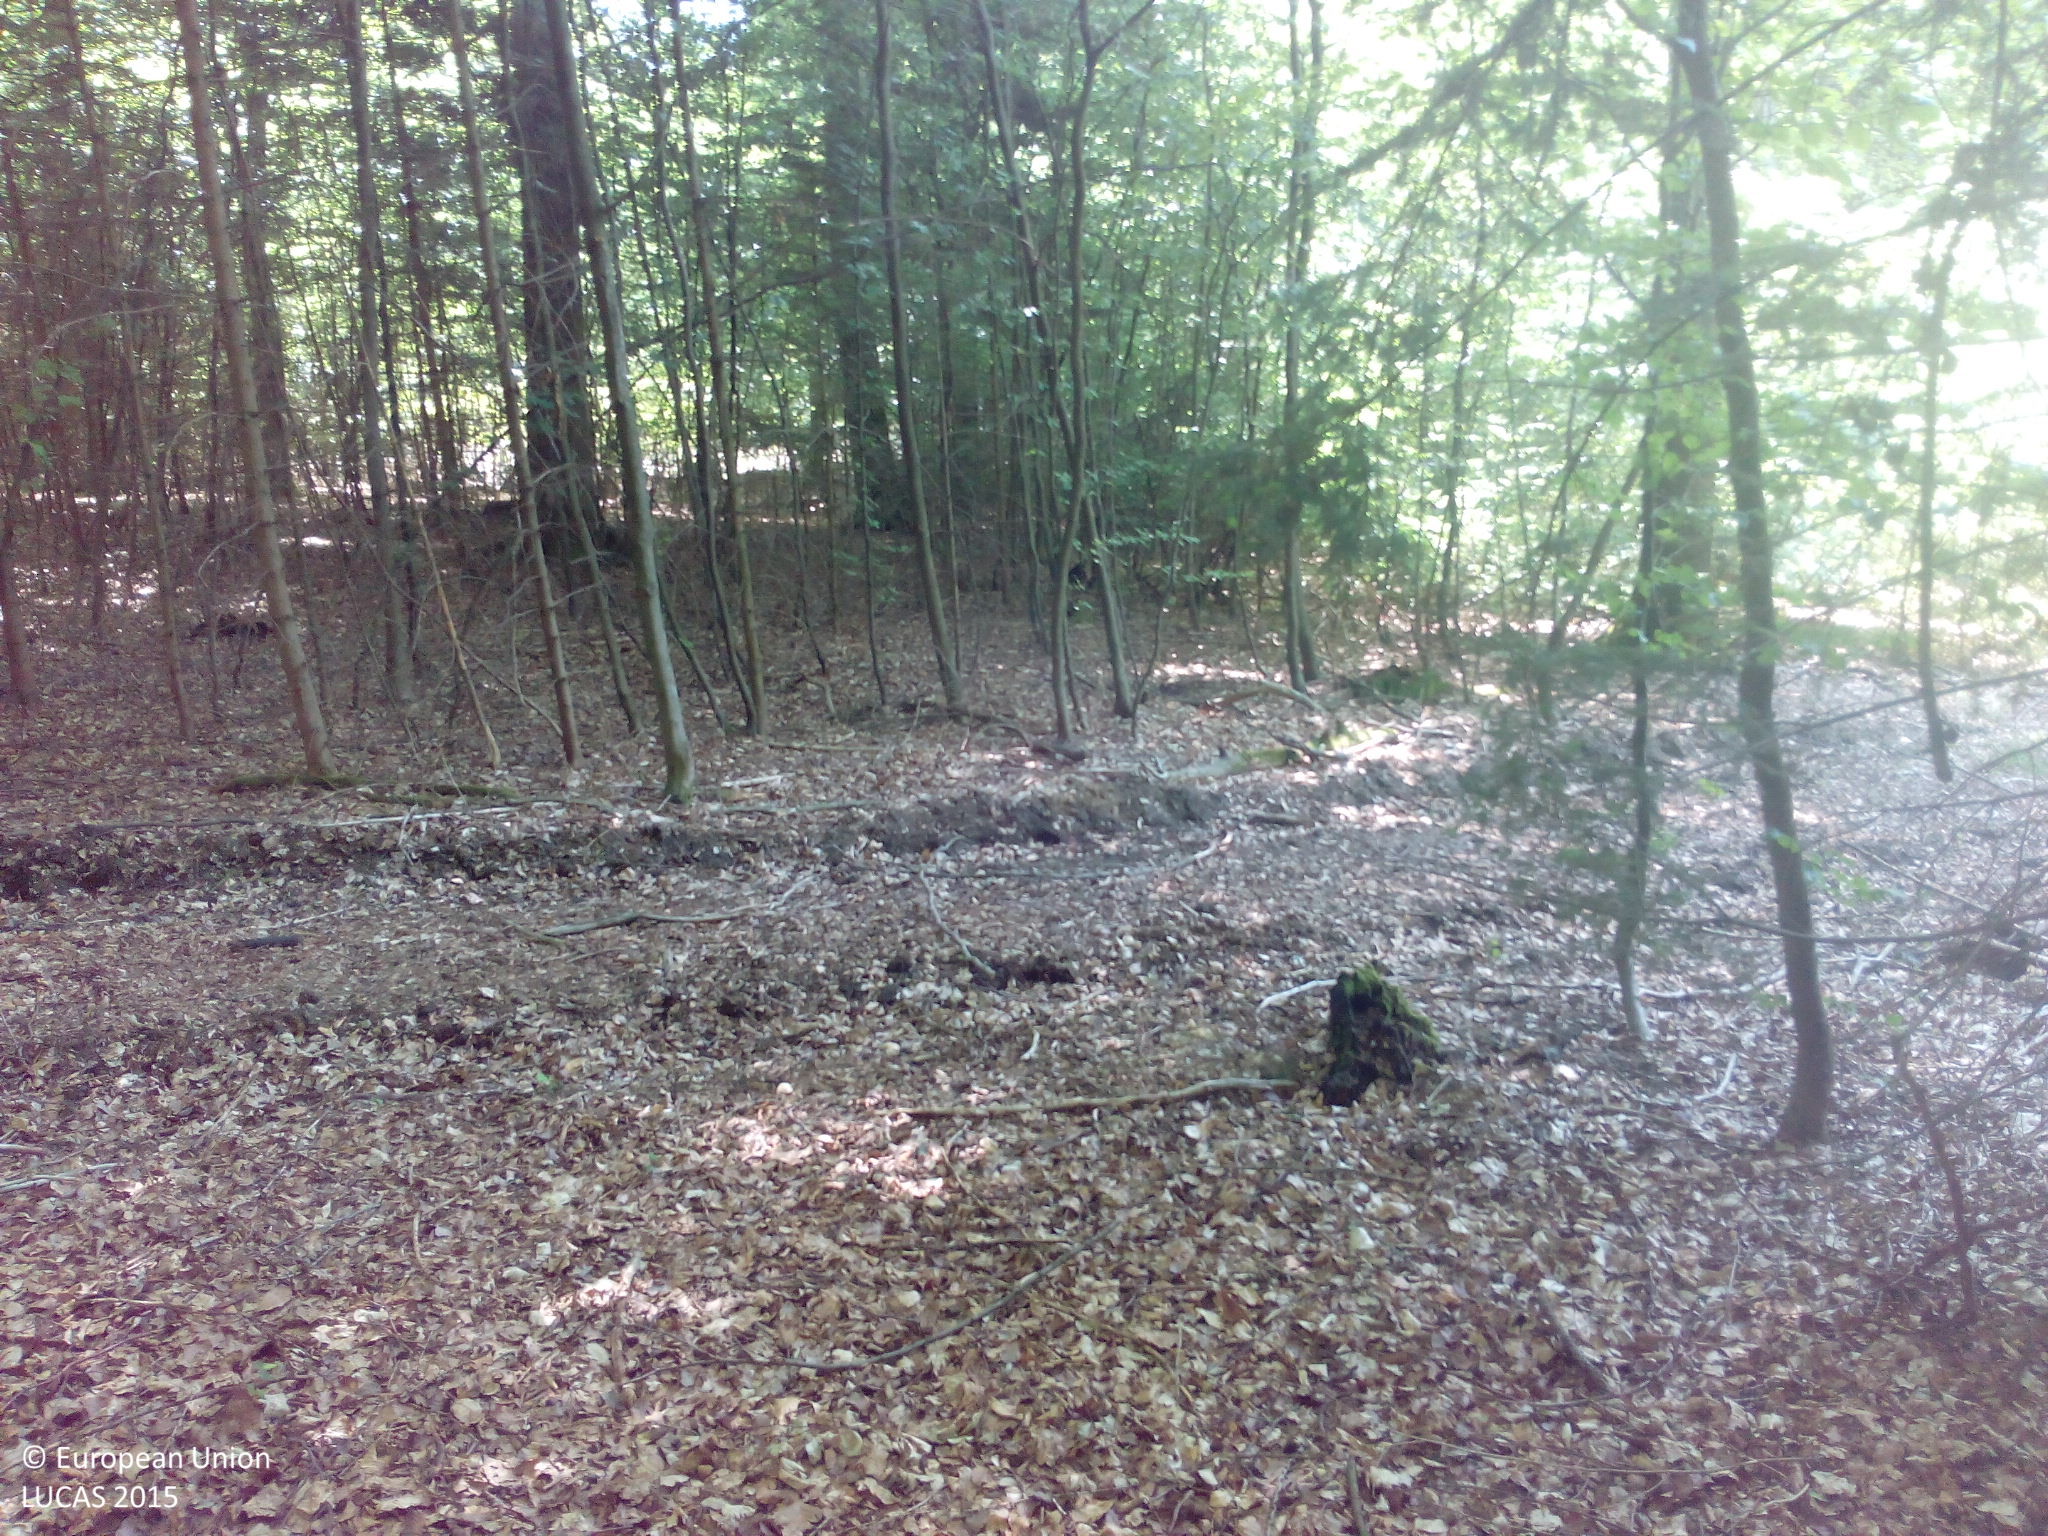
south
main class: Woodland
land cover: Broadleaved woodland
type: mesophytic deciduous forest
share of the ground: > 75 %
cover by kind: broadleaved forest trees 95 %, unconsolidated bare surface 5 %
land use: Forestry
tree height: > 5 m
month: June
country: DE
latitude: 50.1147
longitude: 8.1125
